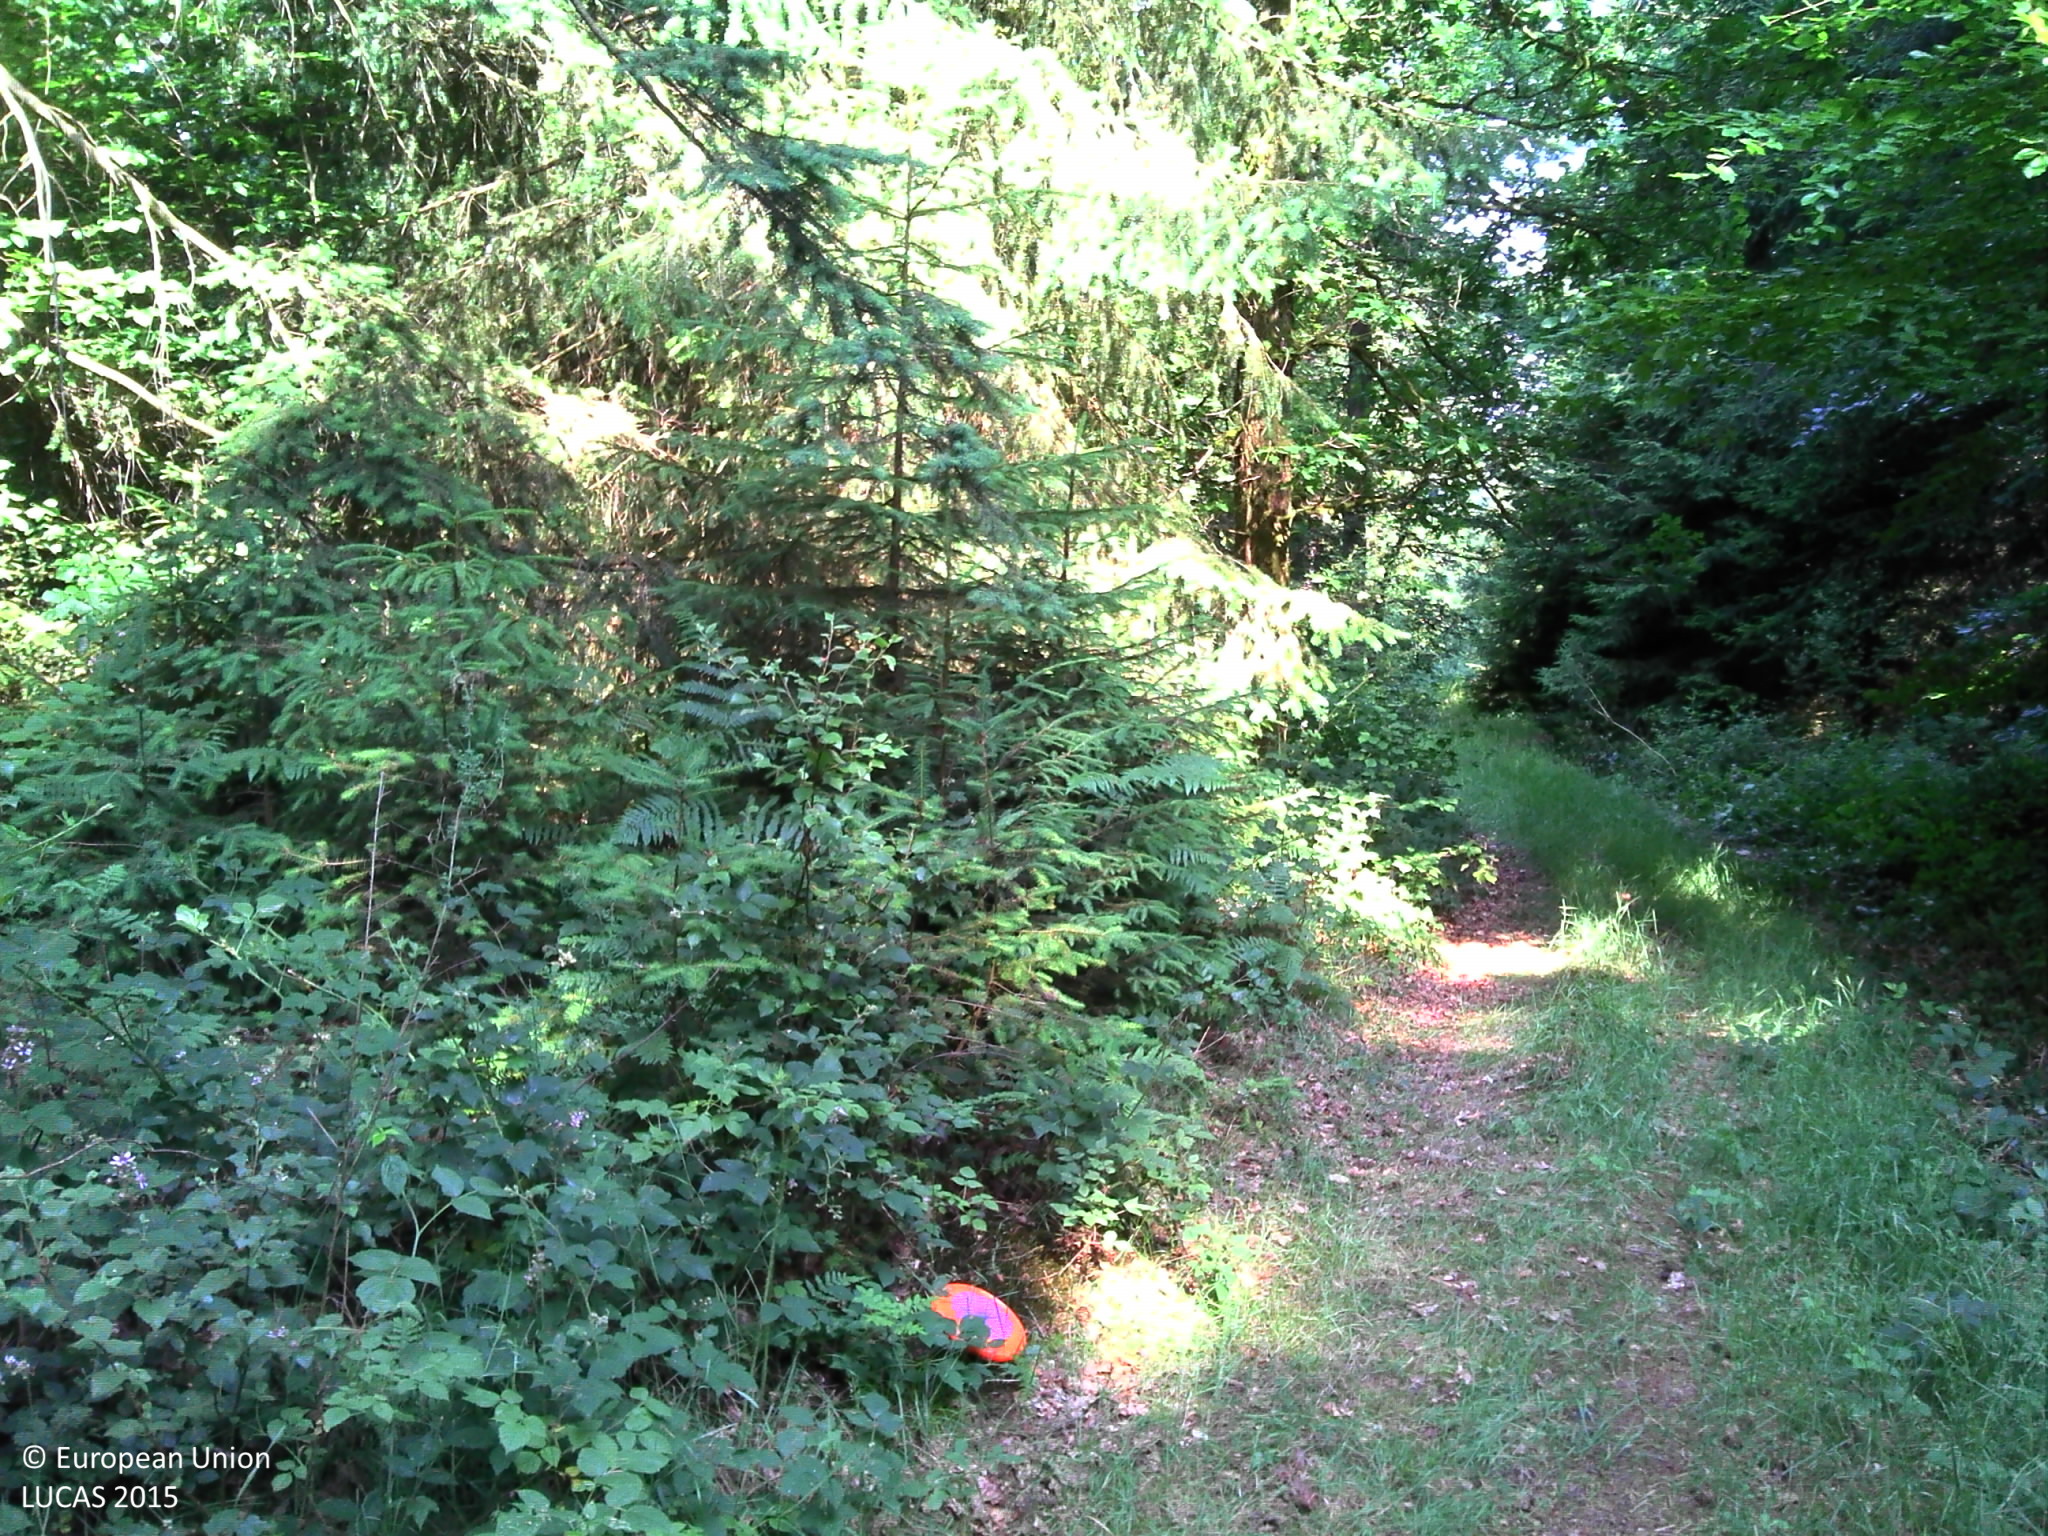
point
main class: Woodland
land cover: Other mixed woodland
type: acidophilous oak and oak-birch forest
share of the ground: > 75 %
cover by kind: coniferous forest trees 65 %, broadleaved forest trees 30 %, herbaceous plants 5 %
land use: Forestry
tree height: > 5 m
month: June
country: BE
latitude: 49.9445
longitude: 4.9108
